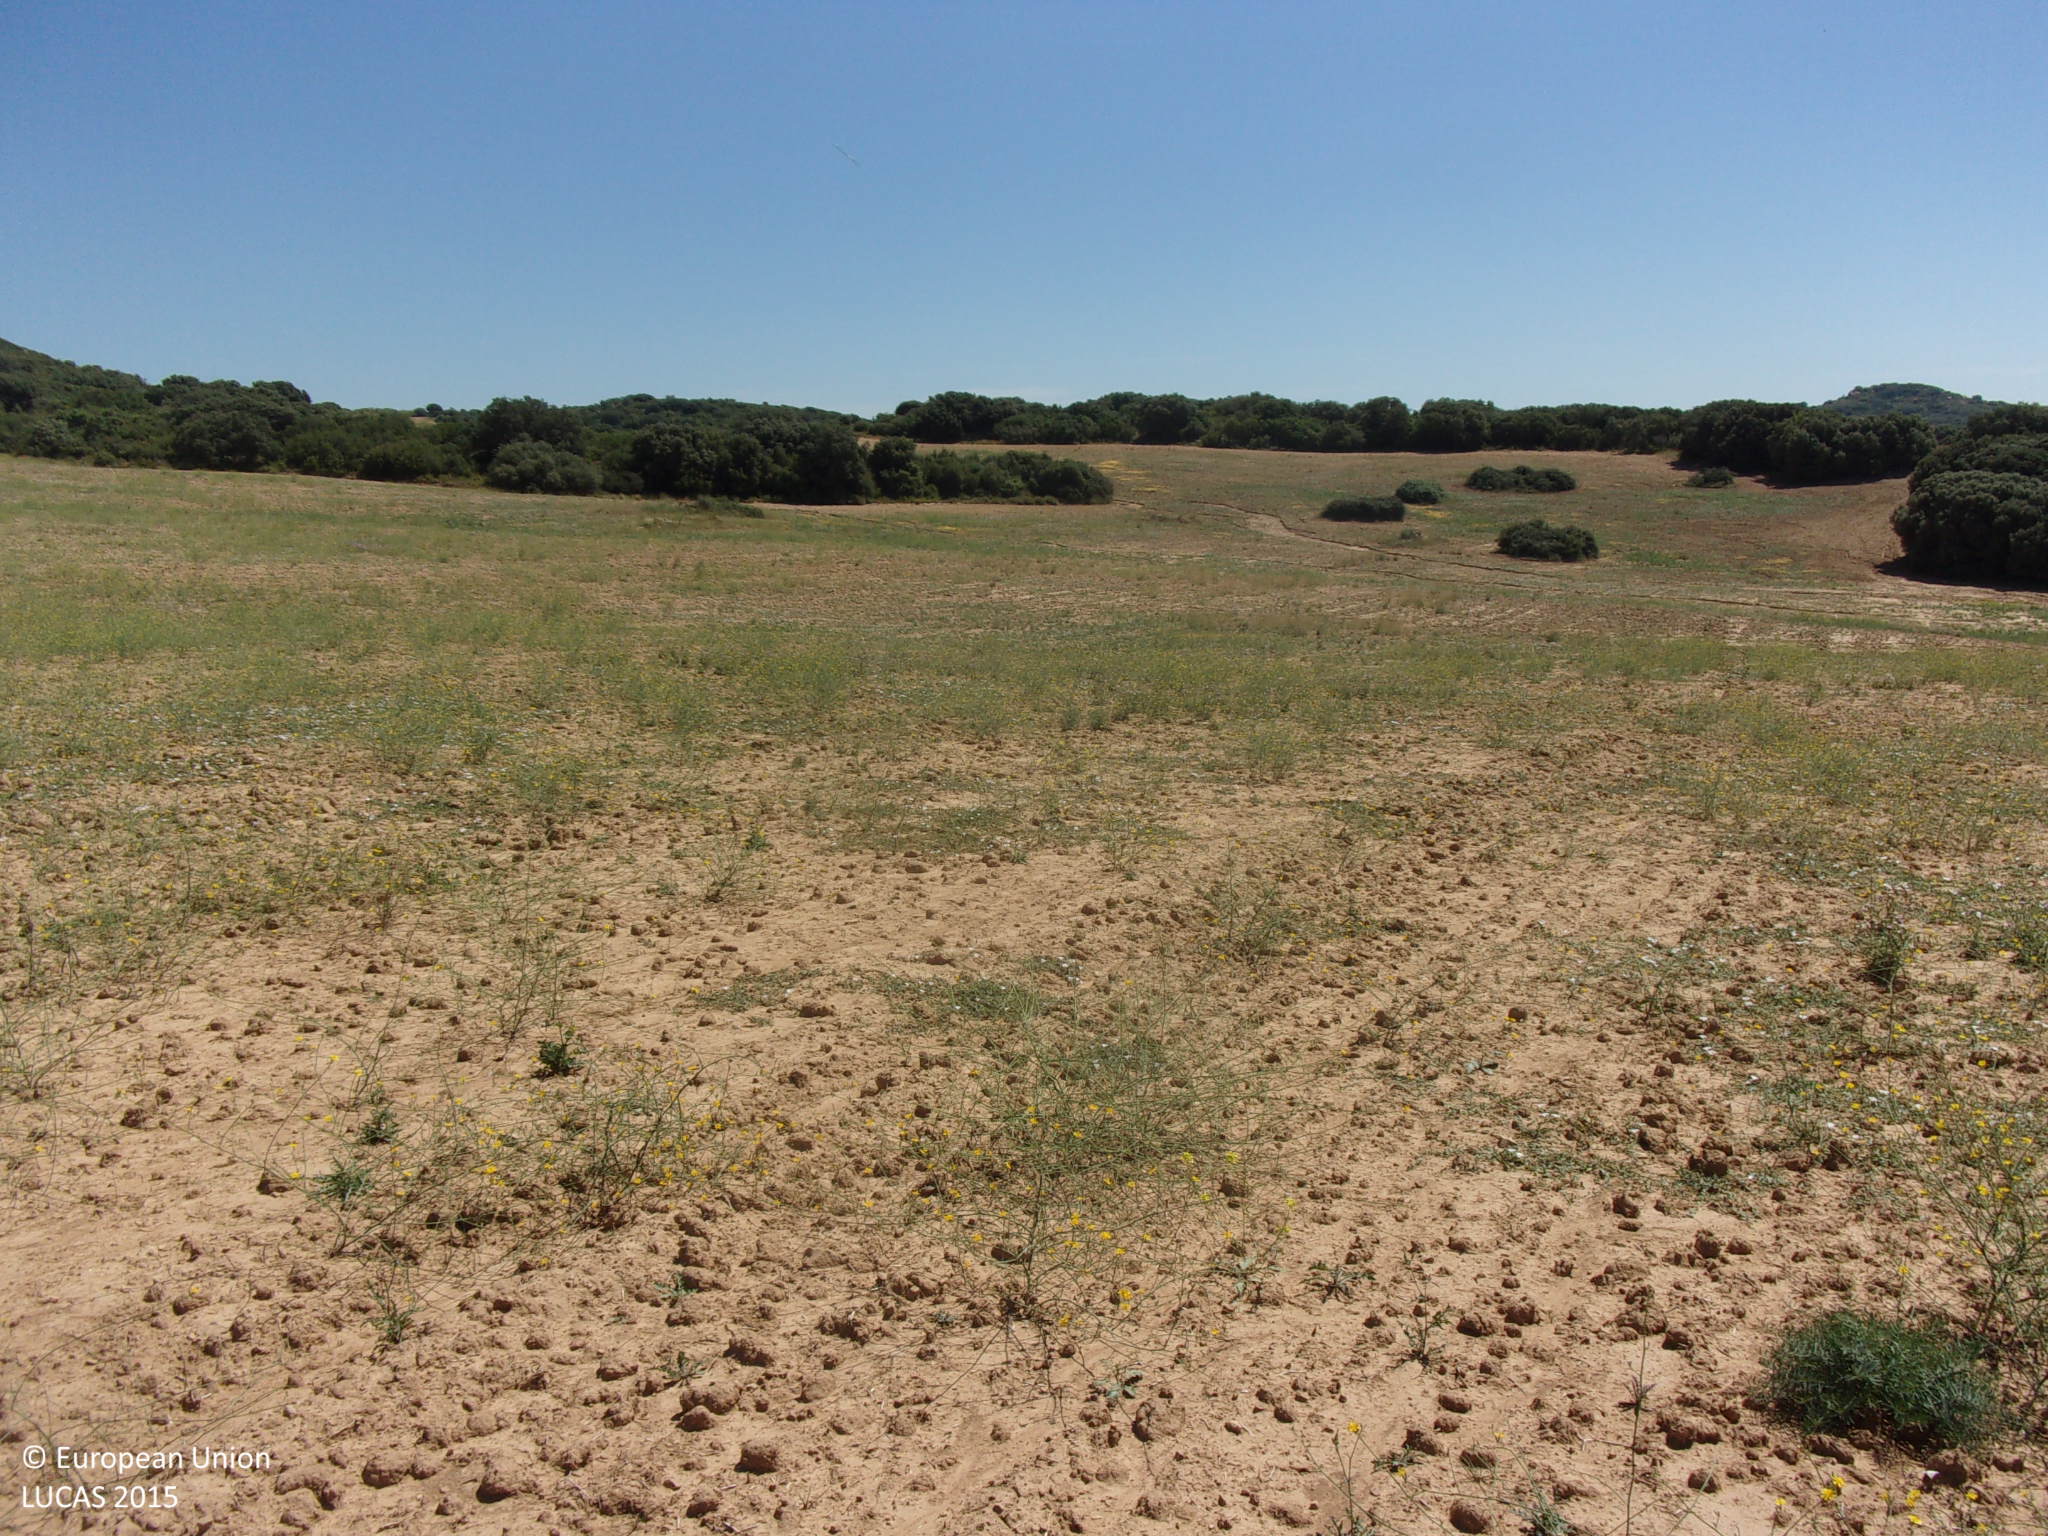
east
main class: Grassland
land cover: Spontaneously vegetated surfaces
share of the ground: 25 - 50 %
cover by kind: unconsolidated bare surface 70 %, herbaceous plants 30 %
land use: Fallow land
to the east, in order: Spontaneously vegetated surfaces; Broadleaved woodland; Spontaneously vegetated surfaces
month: August
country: ES
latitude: 42.3600
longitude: -1.1887
